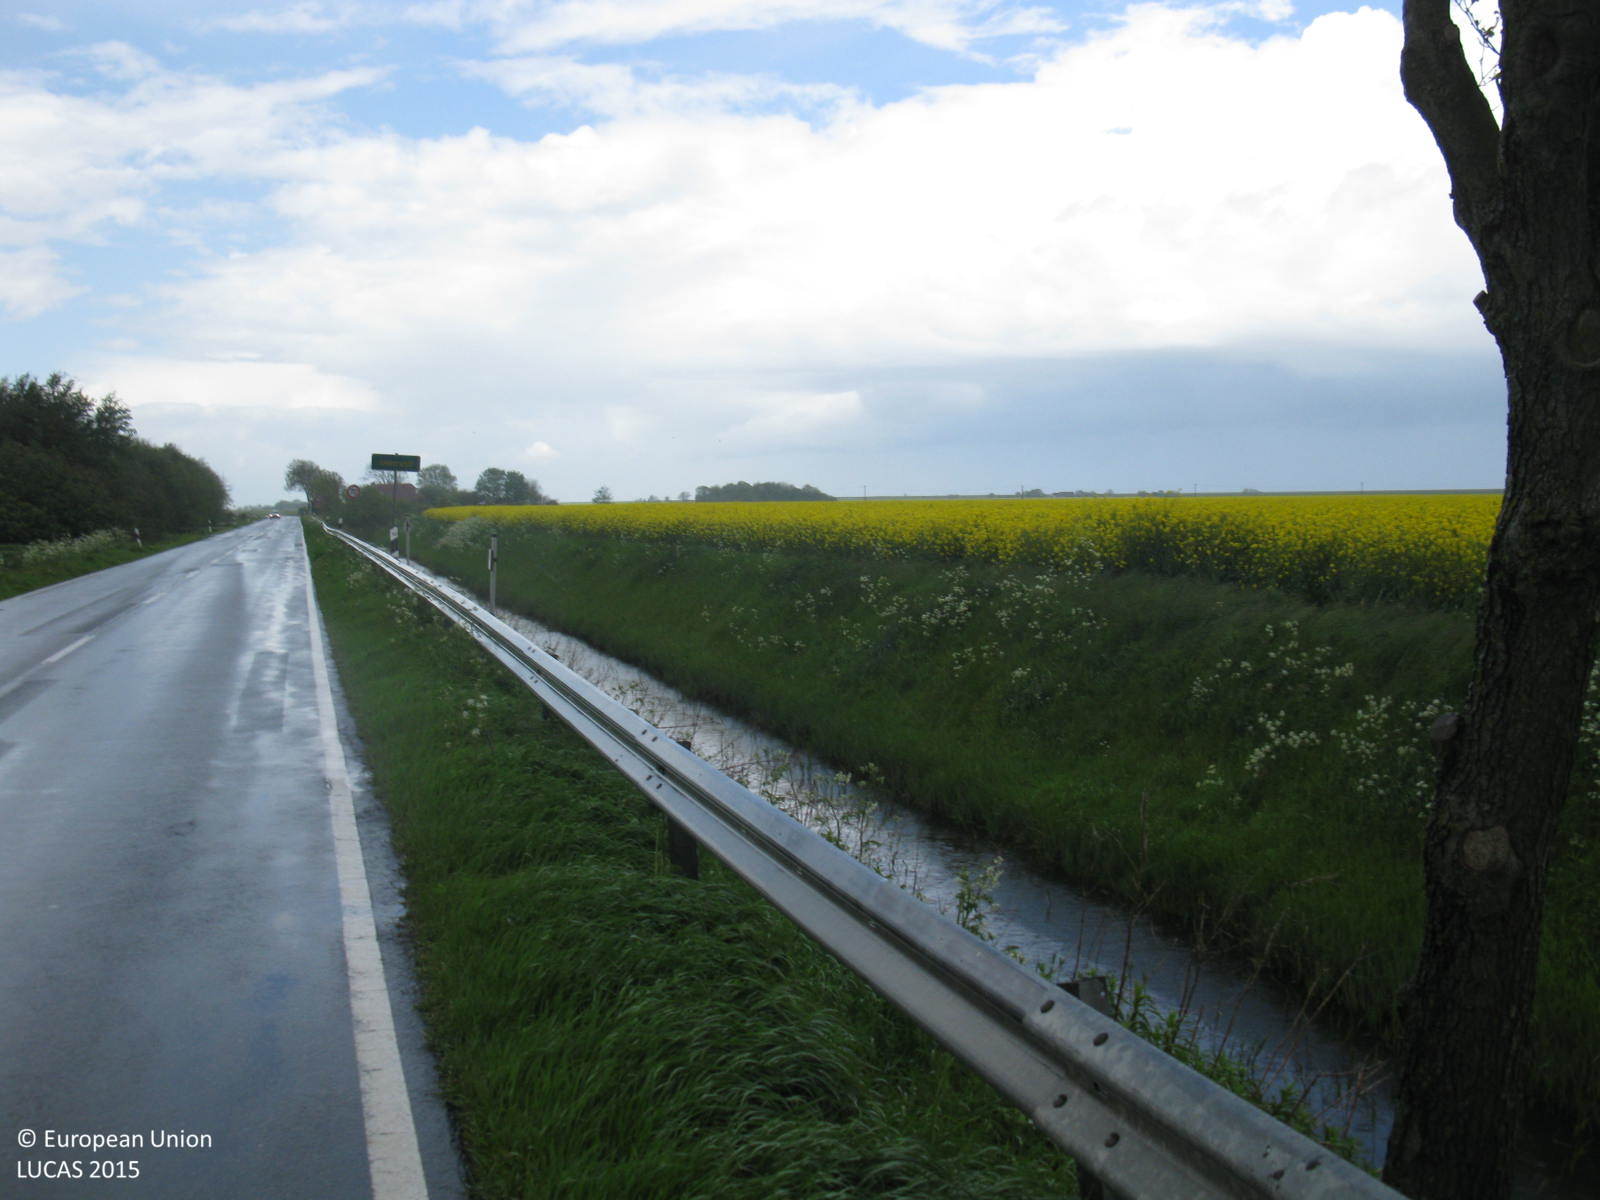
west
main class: Cropland
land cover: Rape and turnip rape
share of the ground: > 75 %
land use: Agriculture (excluding fallow land and kitchen gardens)
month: May
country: DE
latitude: 53.6587
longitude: 7.2618
